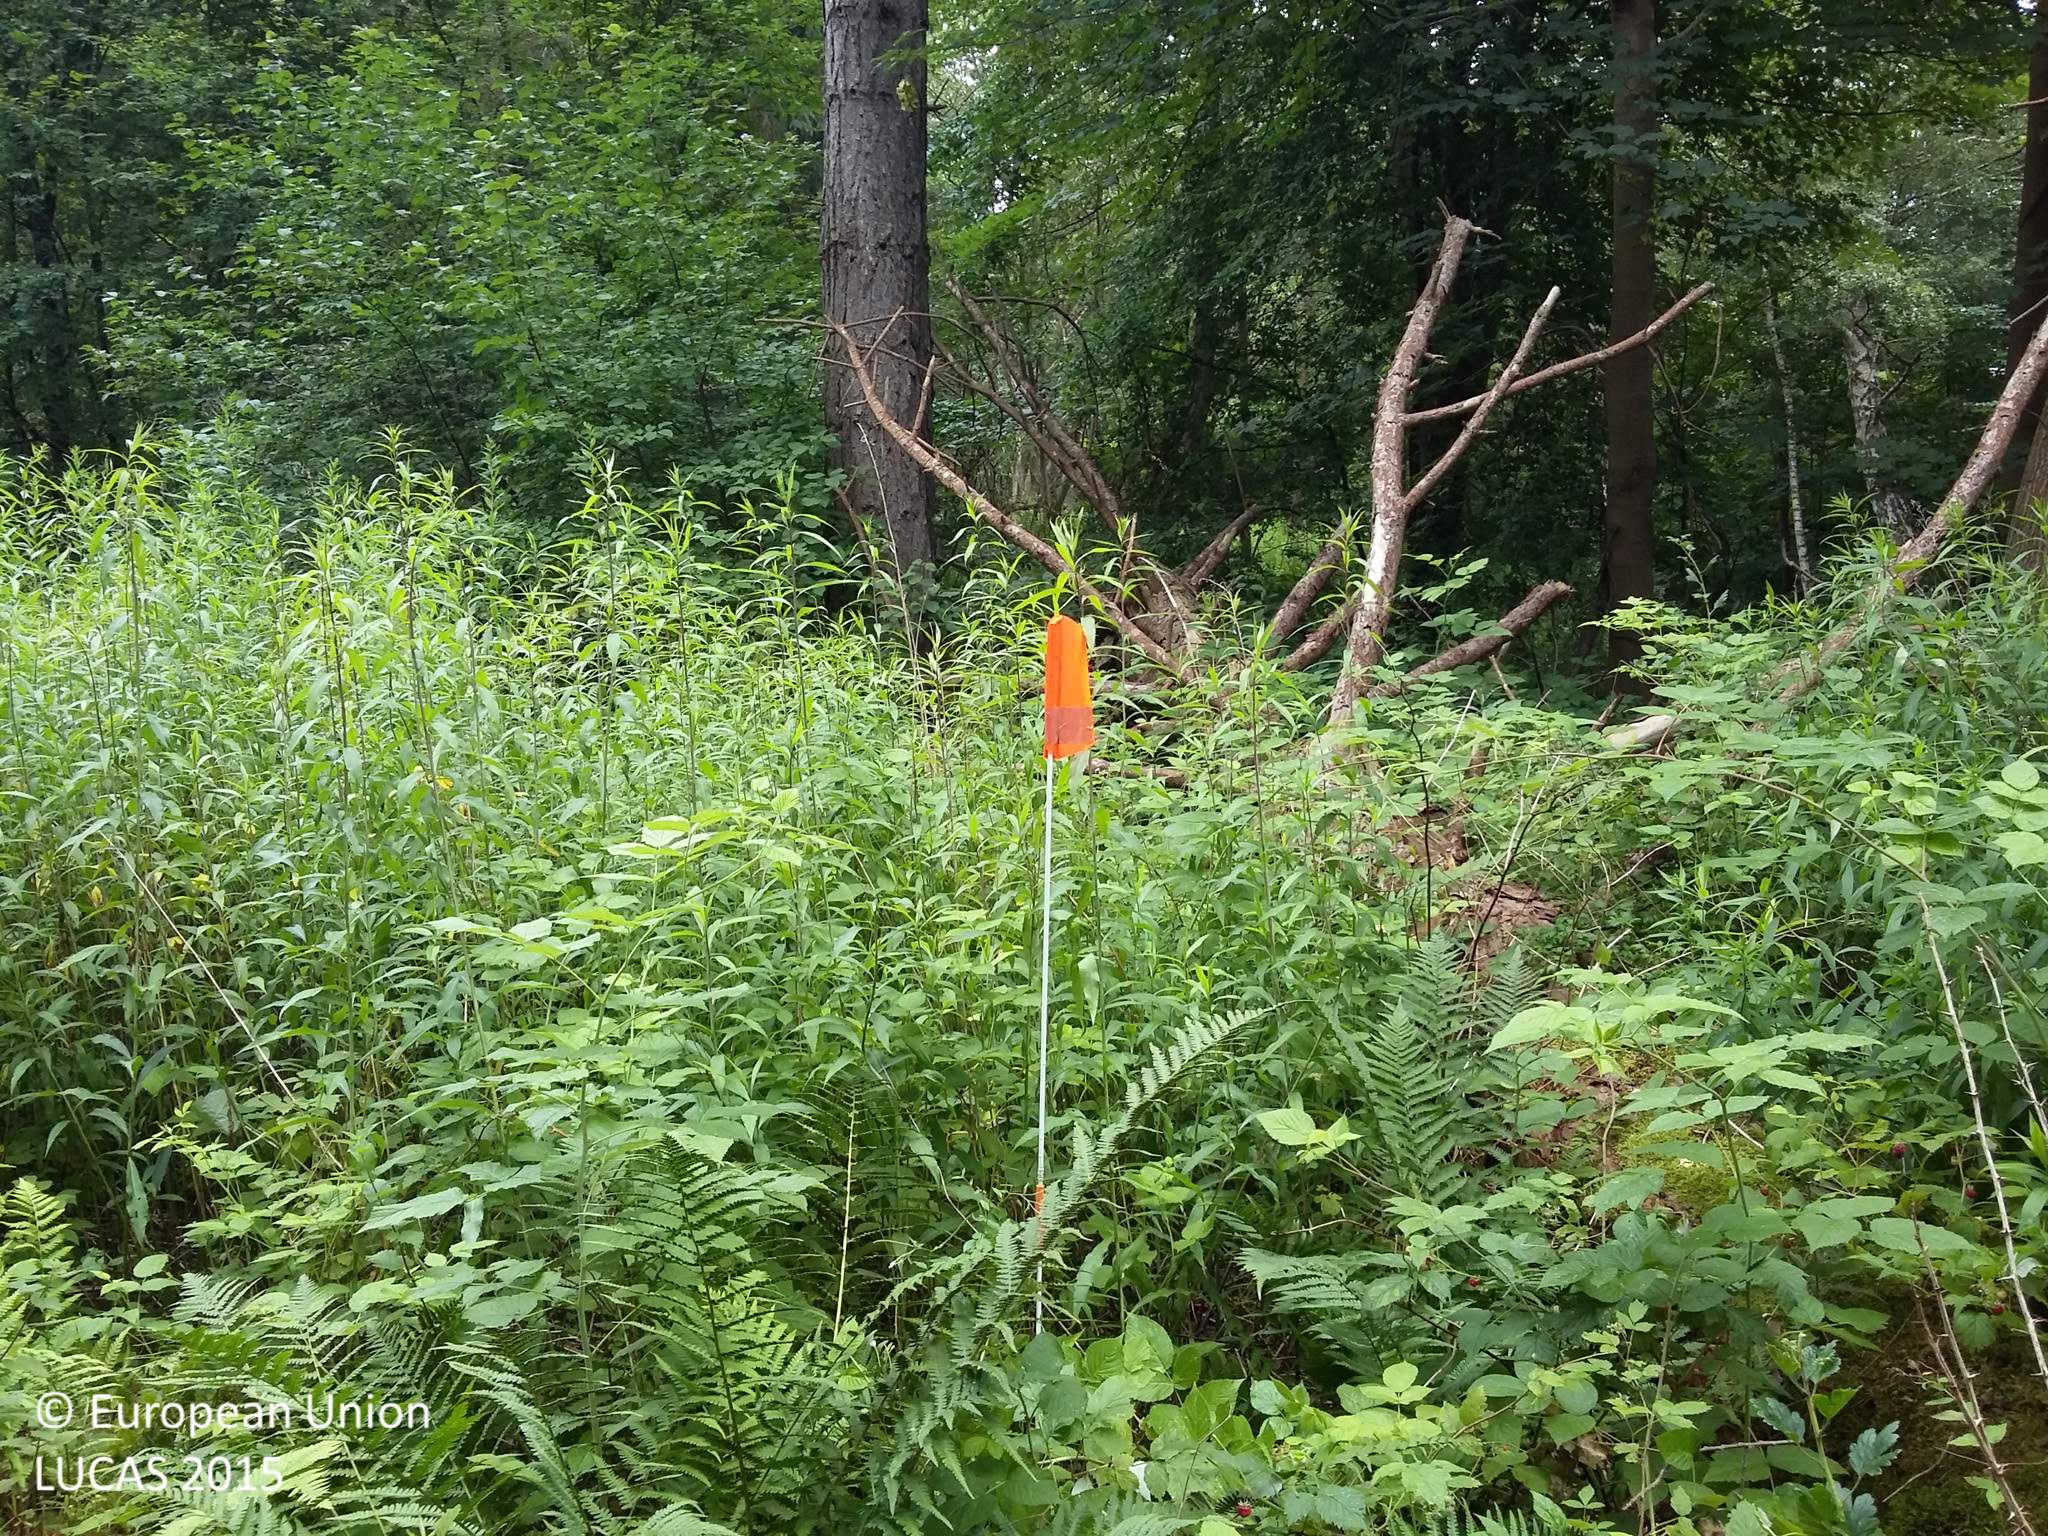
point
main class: Woodland
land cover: Broadleaved woodland
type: thermophilous deciduous forest
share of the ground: 50 - 75 %
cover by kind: herbaceous plants 50 %, broadleaved forest trees 45 %, coniferous forest trees 5 %
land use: Semi-natural and natural areas not in use
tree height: > 5 m
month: July
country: DK
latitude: 55.8031
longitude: 12.5345
